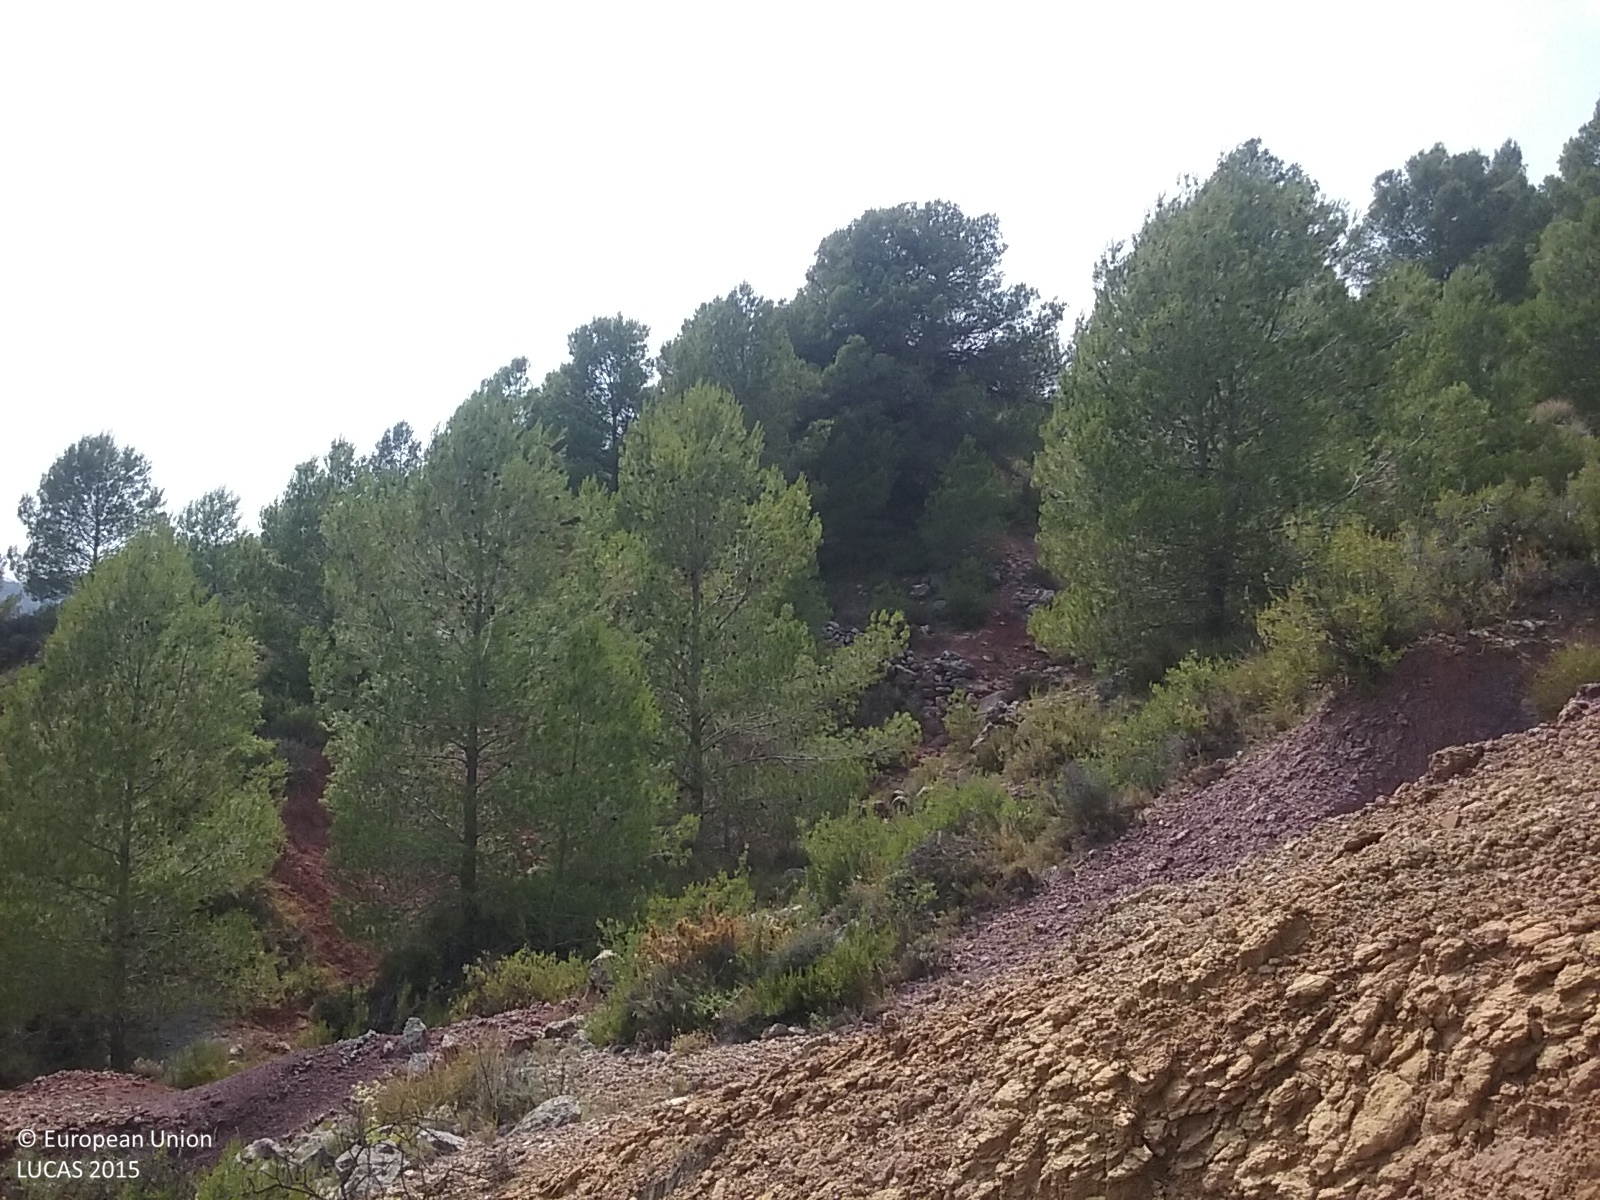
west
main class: Woodland
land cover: Pine dominated coniferous woodland
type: coniferous forest of the mediterranean region
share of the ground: 10 - 25 %
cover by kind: shrubs 40 %, unconsolidated bare surface 40 %, coniferous forest trees 10 %, herbaceous plants 10 %
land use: Semi-natural and natural areas not in use
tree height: < 5 m
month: July
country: ES
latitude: 39.9217
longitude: -0.6621
